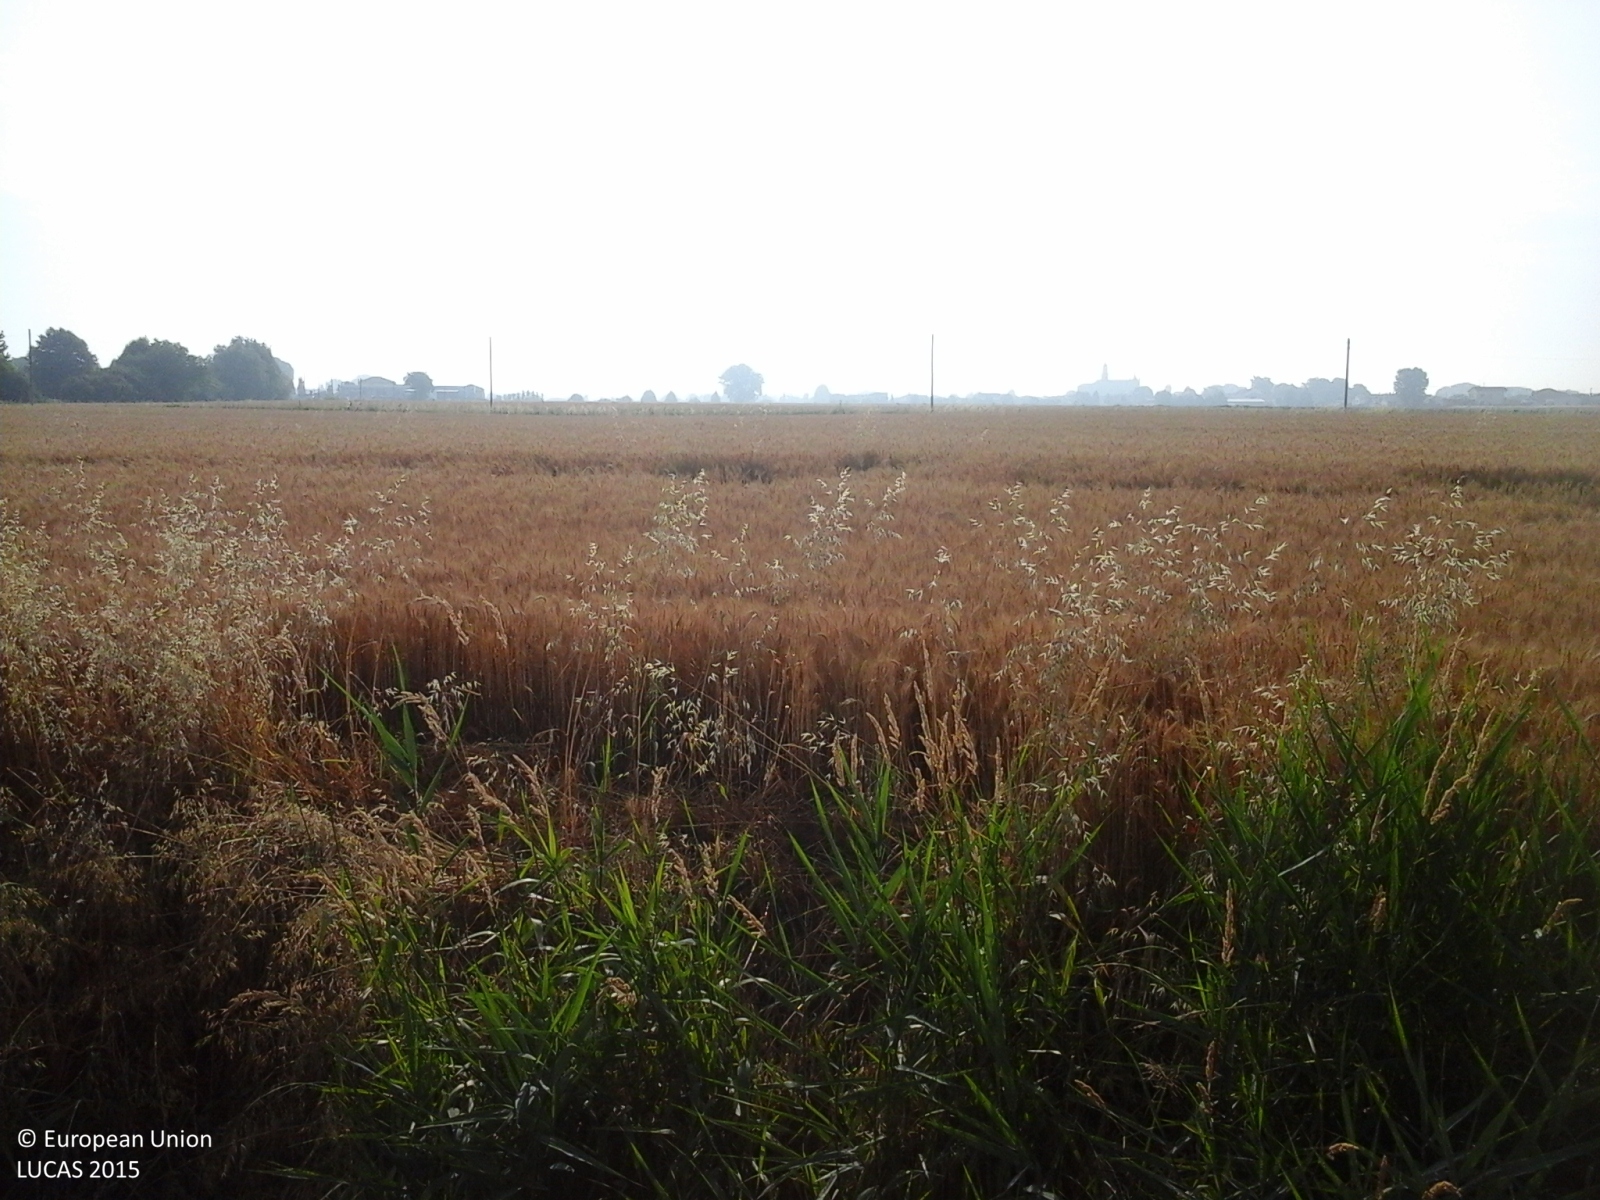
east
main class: Cropland
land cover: Common wheat
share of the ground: > 75 %
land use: Agriculture (excluding fallow land and kitchen gardens)
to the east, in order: Common wheat; Electric lines; Ditches and canals; Common wheat
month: June
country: IT
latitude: 45.1733
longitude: 11.1812
